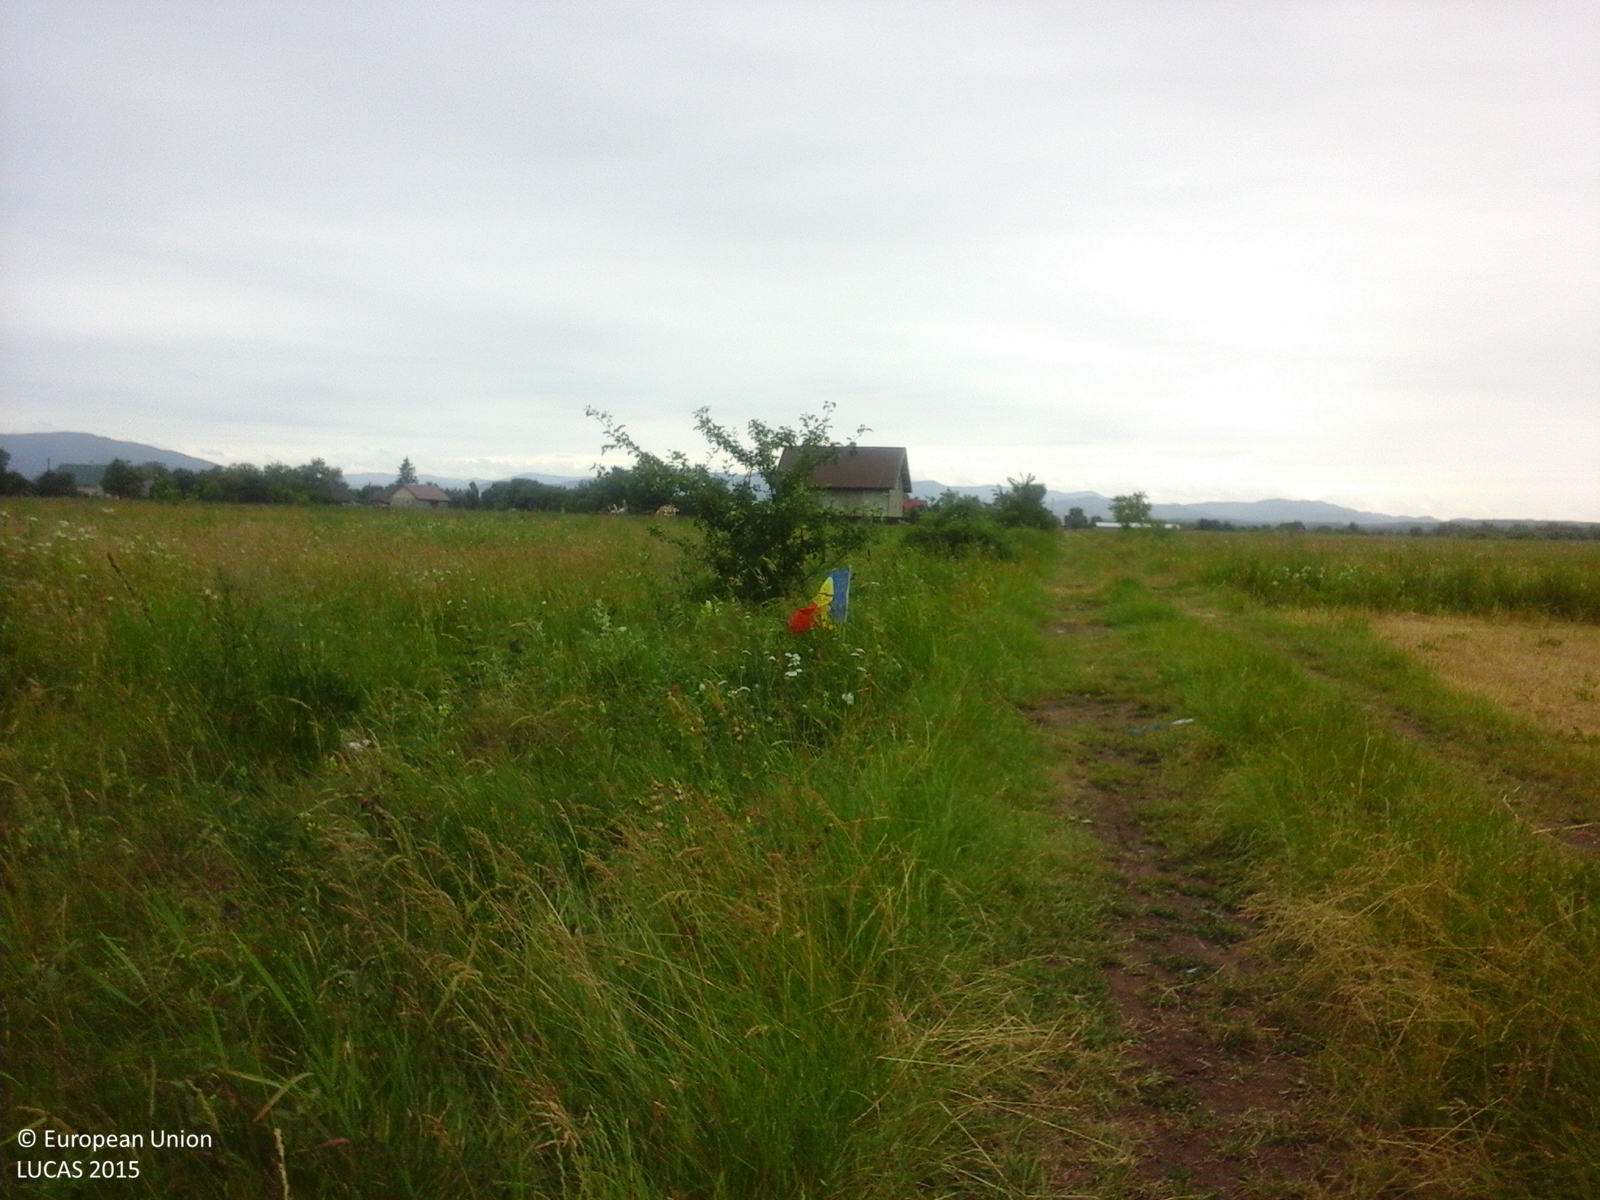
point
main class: Grassland
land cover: Grassland without tree/shrub cover
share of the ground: > 75 %
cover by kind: herbaceous plants 100 %
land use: Agriculture (excluding fallow land and kitchen gardens)
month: June
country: RO
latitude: 47.9300
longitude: 25.7174
